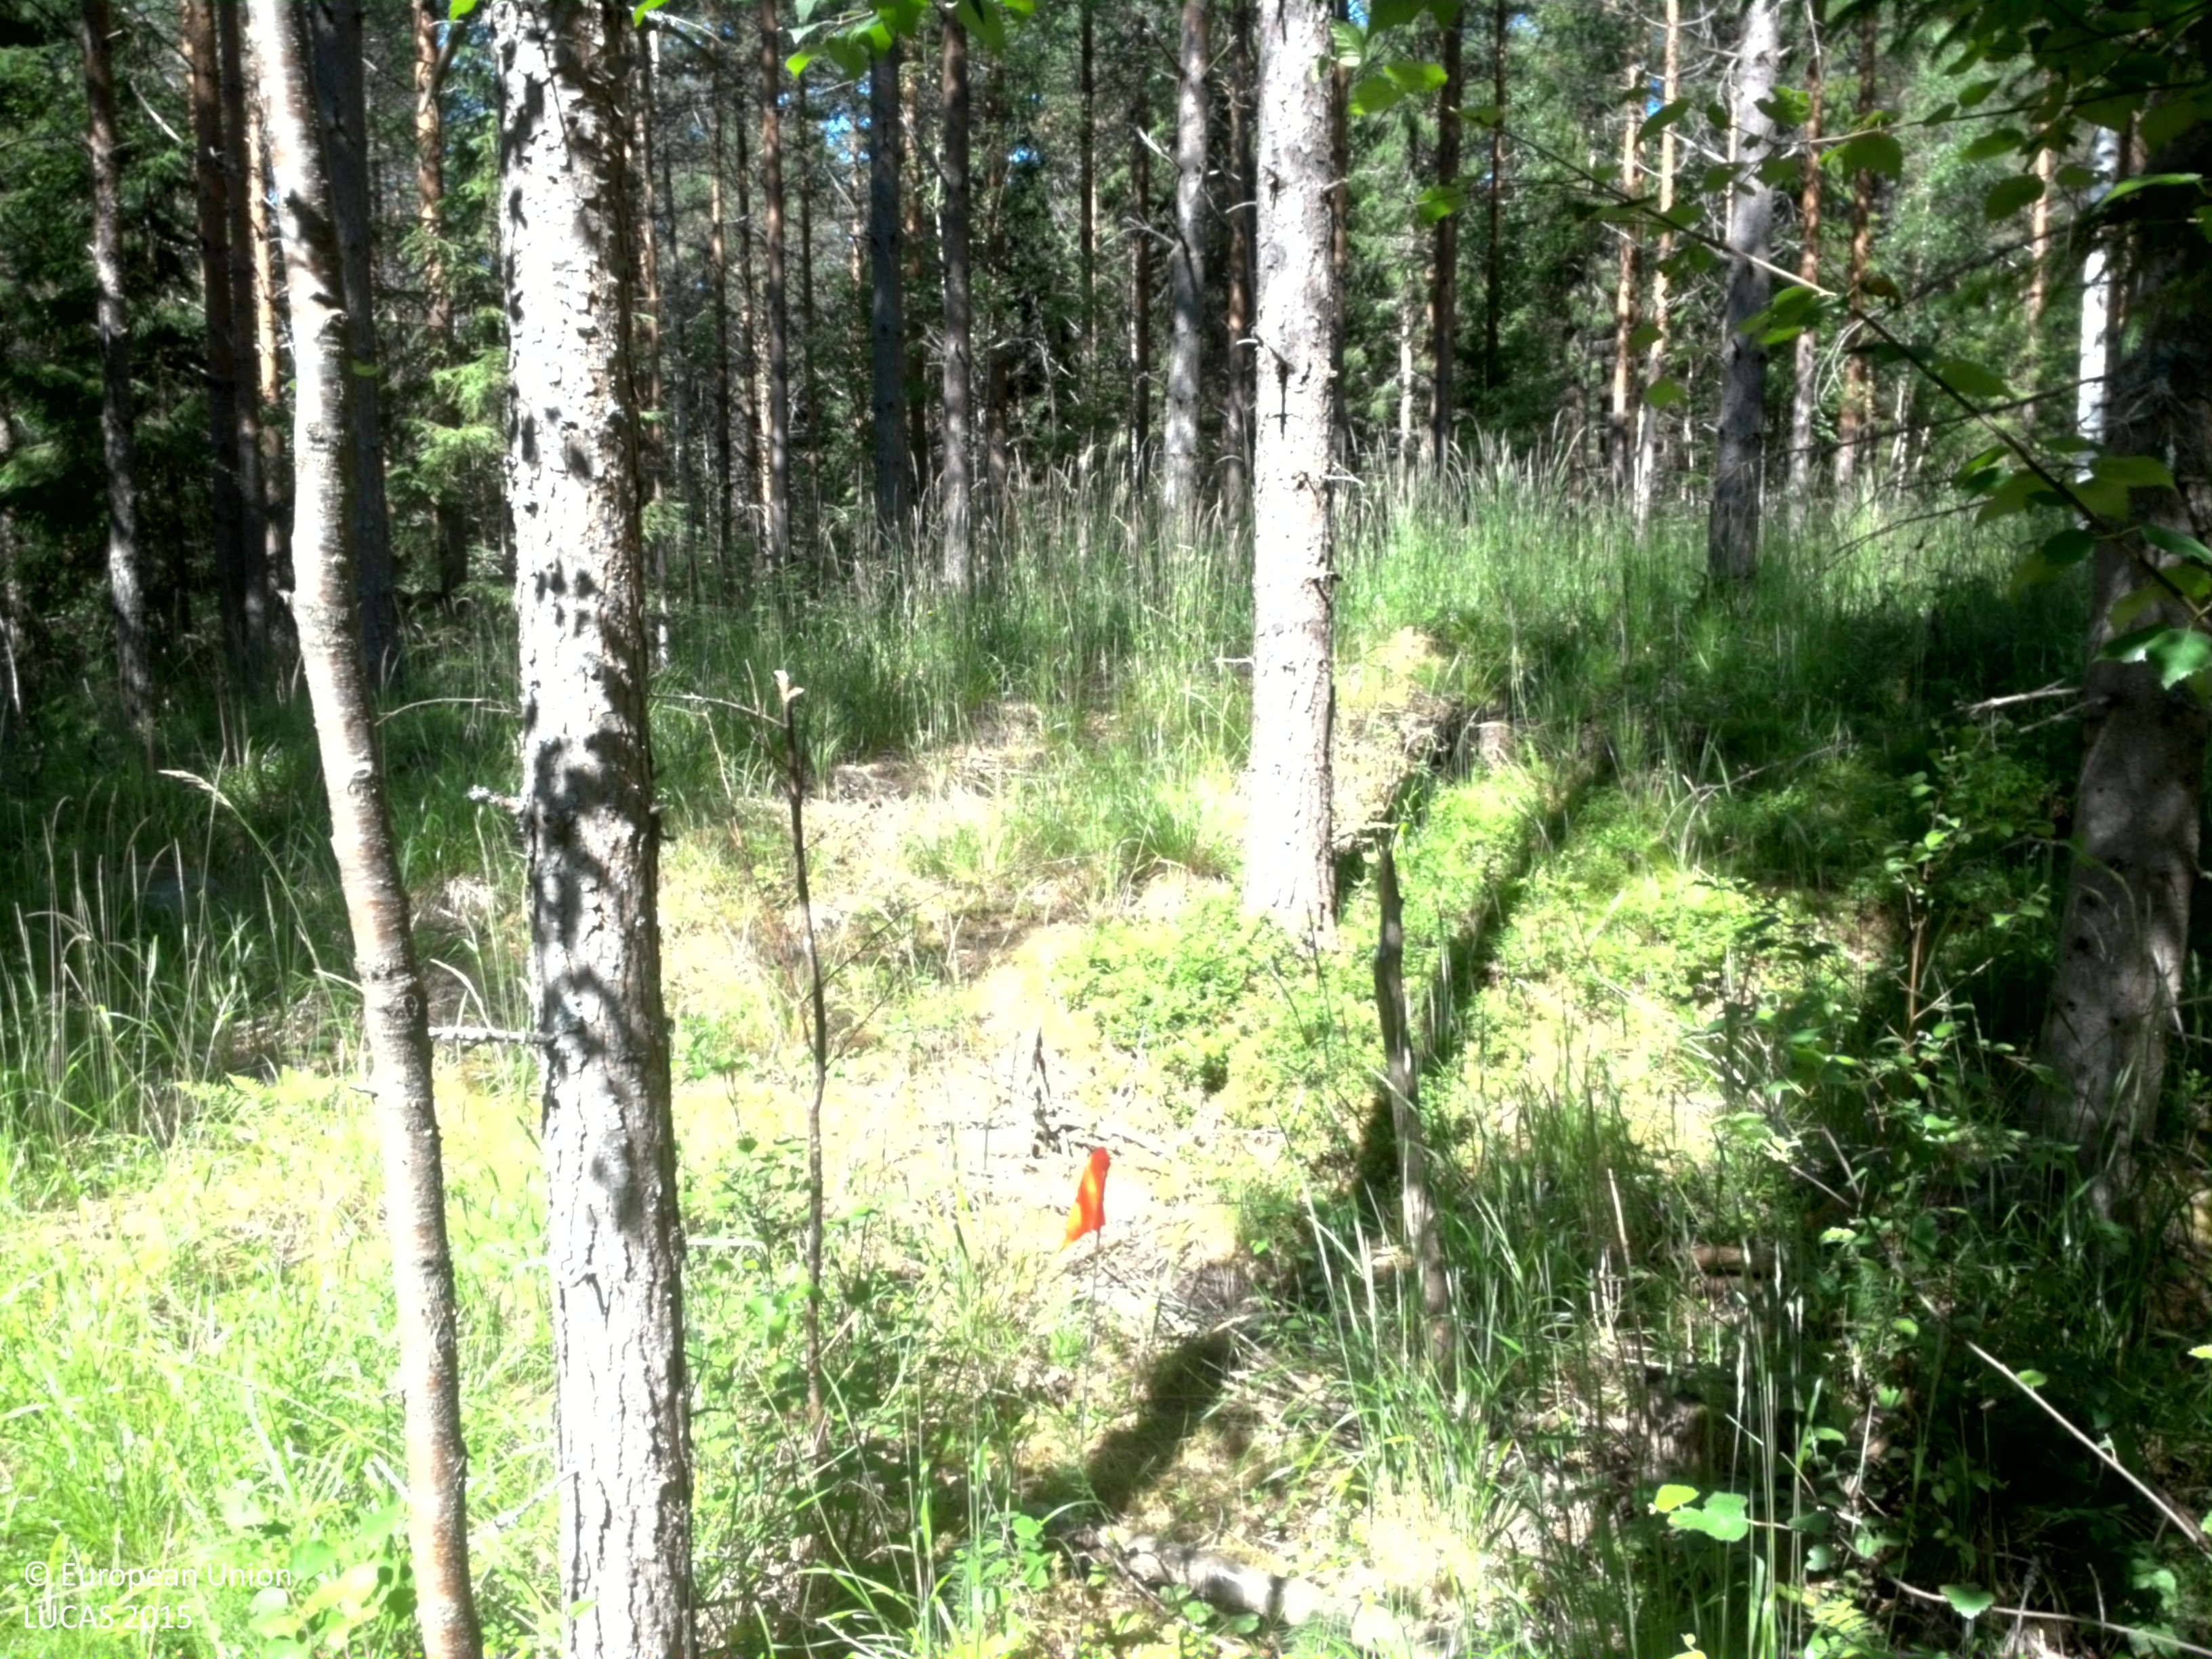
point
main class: Woodland
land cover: Pine dominated coniferous woodland
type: boreal forest
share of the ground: 50 - 75 %
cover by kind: coniferous forest trees 40 %, herbaceous plants 35 %, broadleaved forest trees 10 %, shrubs 10 %, lichens and mosses 5 %
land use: Forestry
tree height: > 5 m
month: July
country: SE
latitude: 59.6518
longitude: 14.6927
